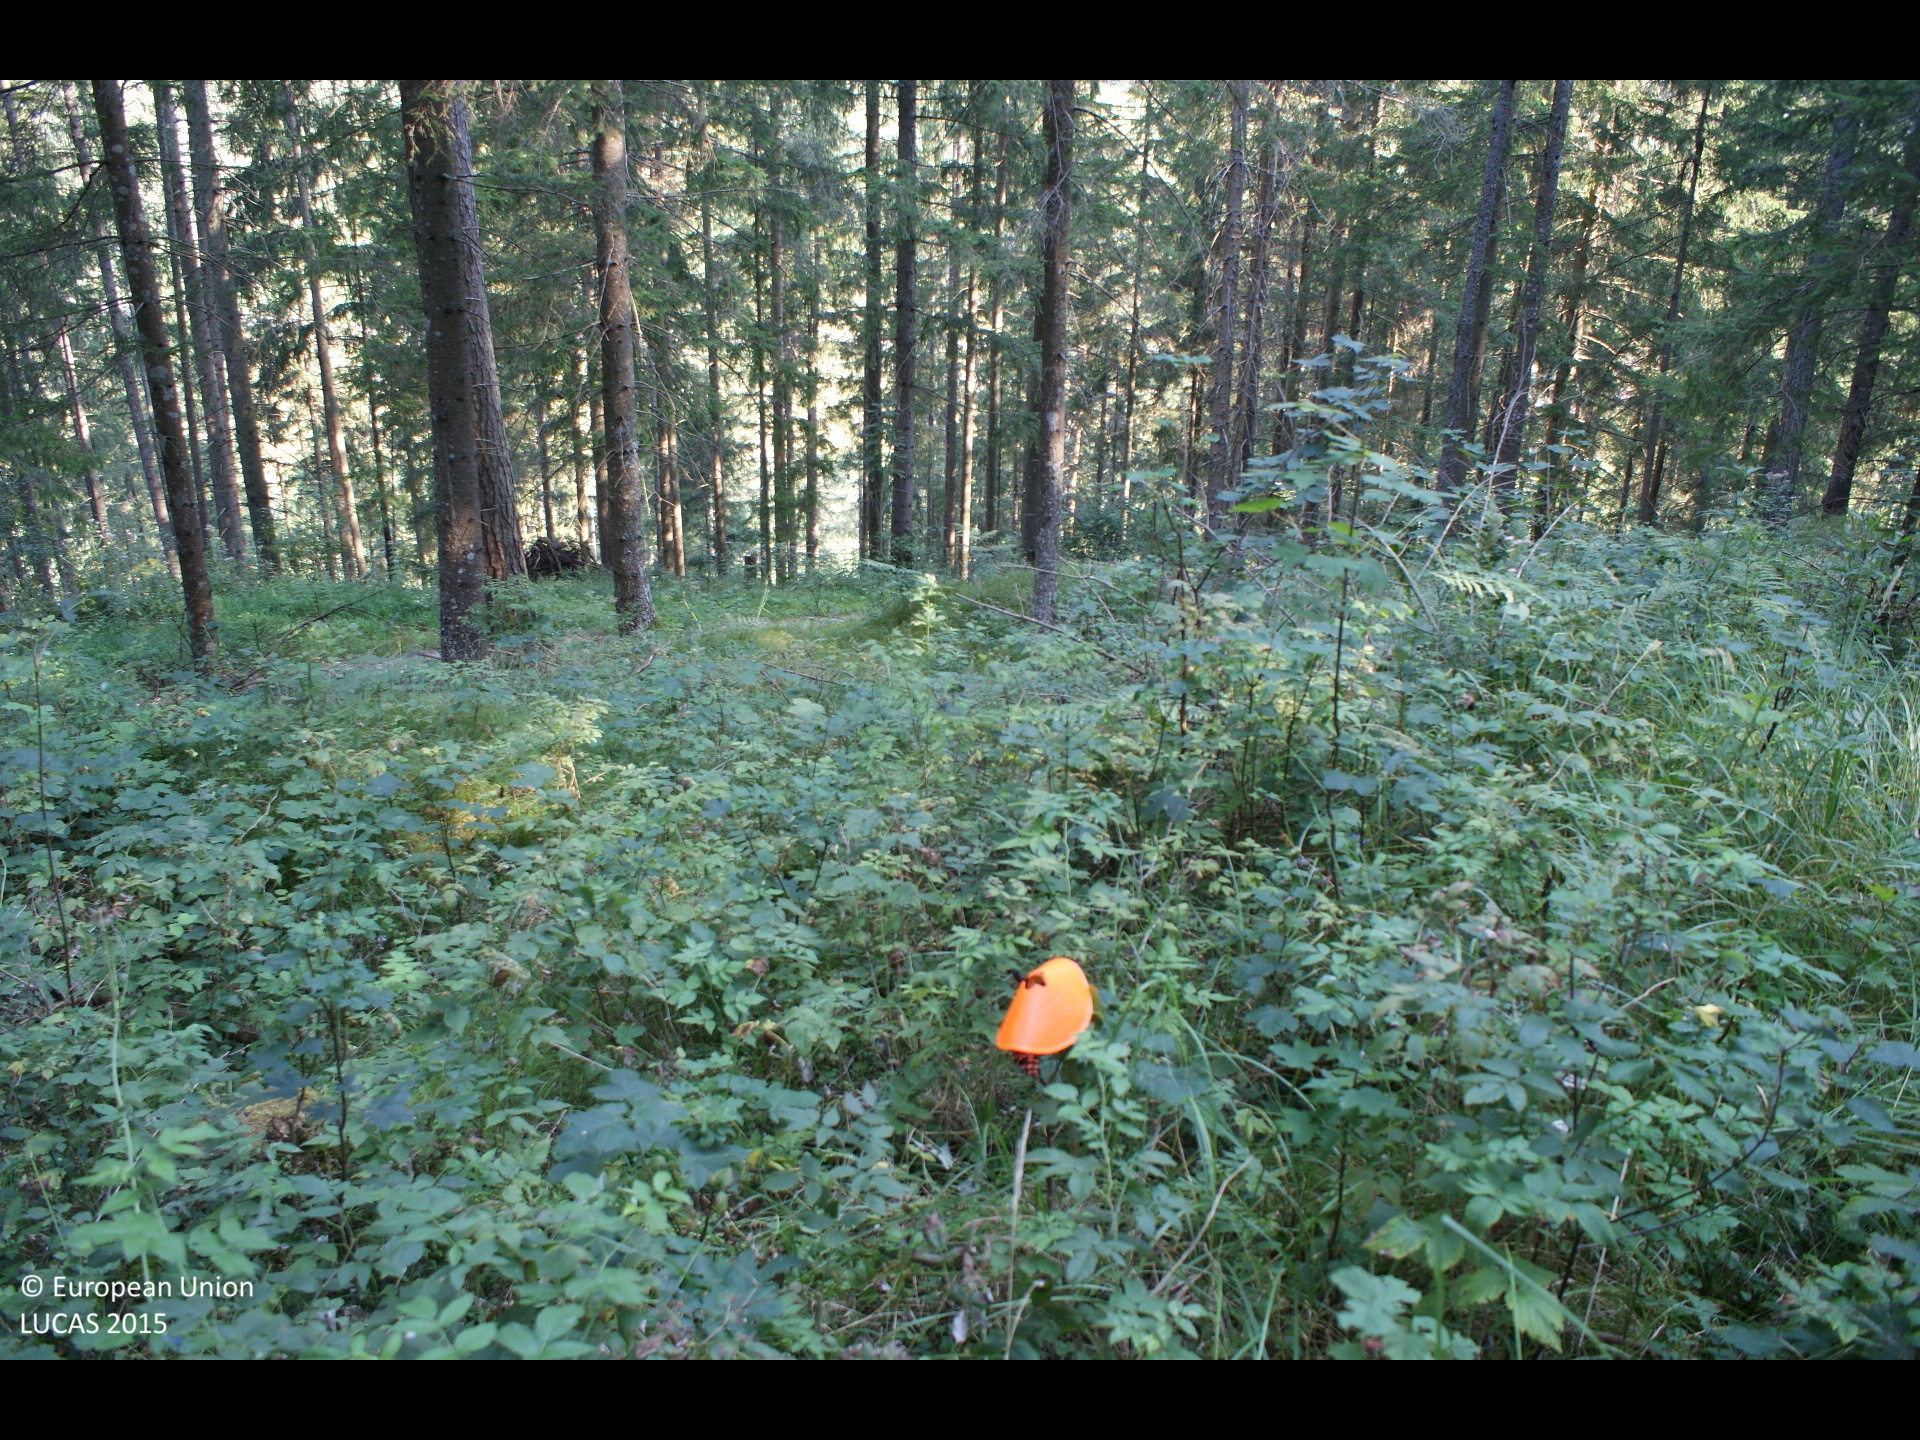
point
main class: Woodland
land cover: Spruce dominated coniferous woodland
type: alpine coniferous forest
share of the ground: 50 - 75 %
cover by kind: coniferous forest trees 50 %, shrubs 30 %, herbaceous plants 20 %
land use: Forestry
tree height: > 5 m
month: August
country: AT
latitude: 47.5369
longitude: 15.3011
